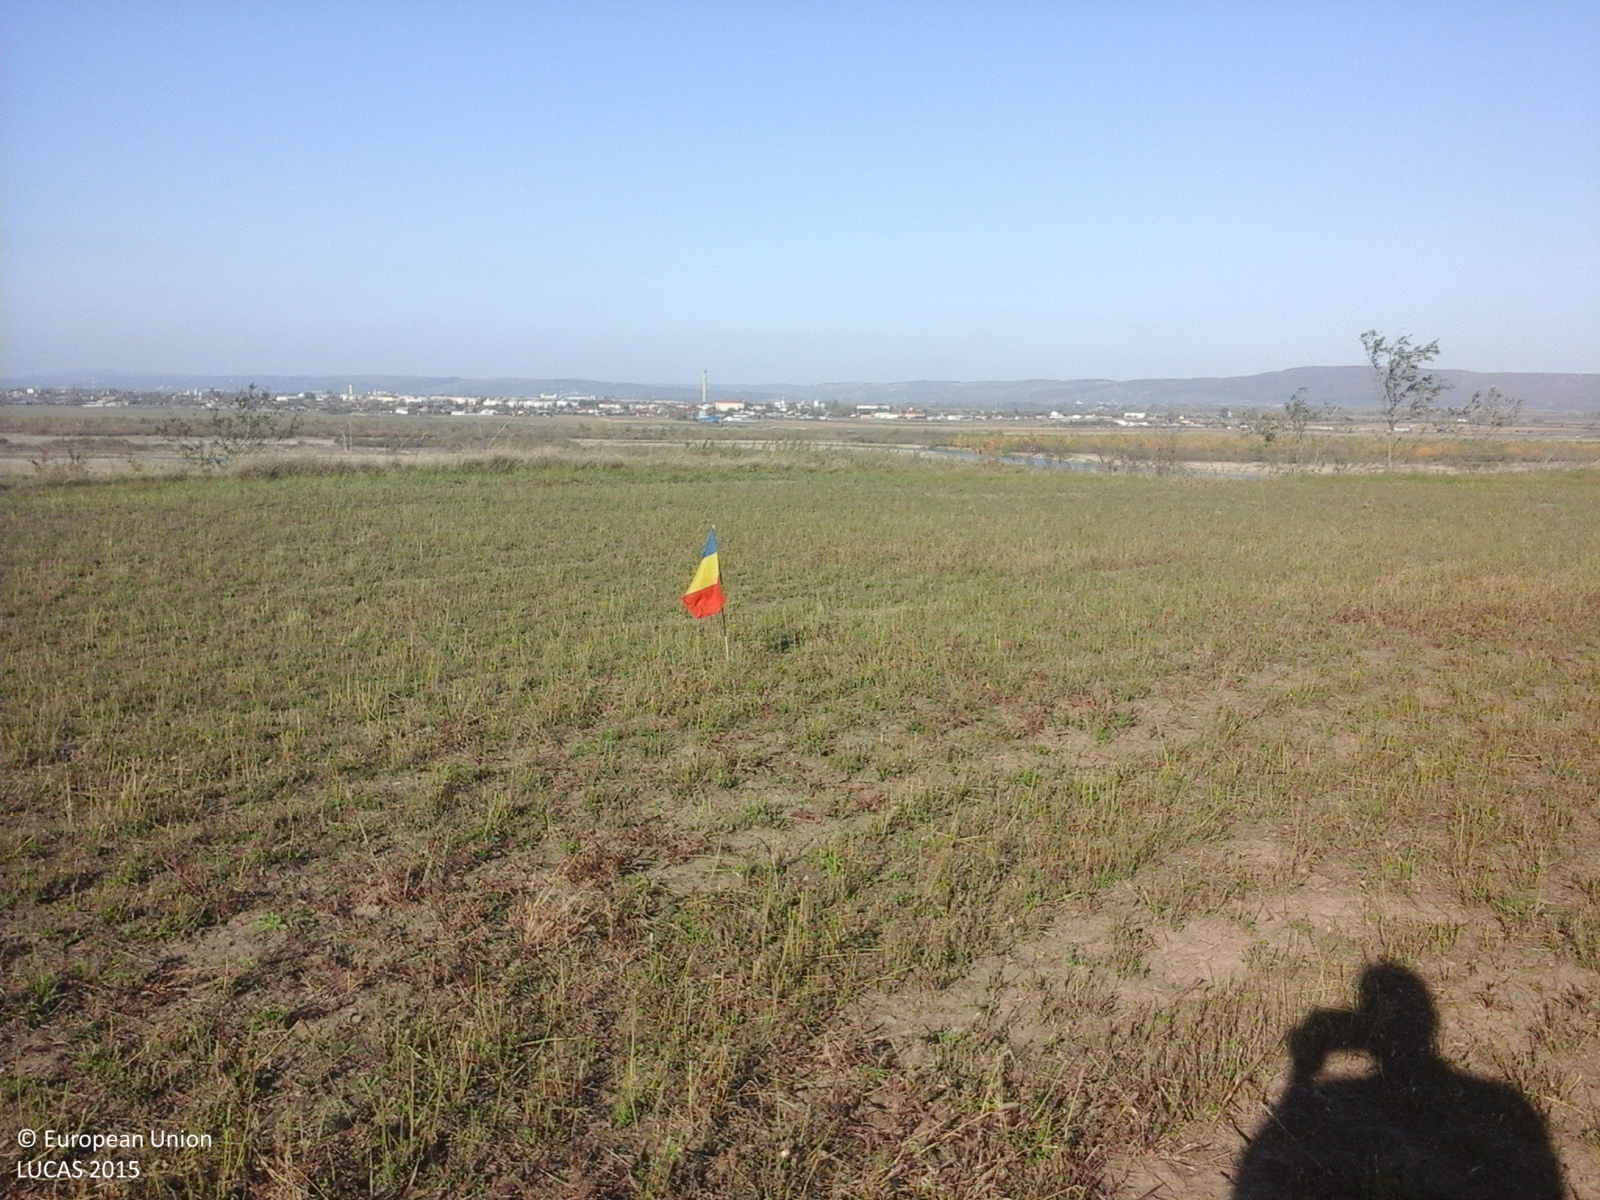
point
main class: Cropland
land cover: Lucerne
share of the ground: 50 - 75 %
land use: Agriculture (excluding fallow land and kitchen gardens)
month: October
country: RO
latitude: 46.0706
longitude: 27.1767
